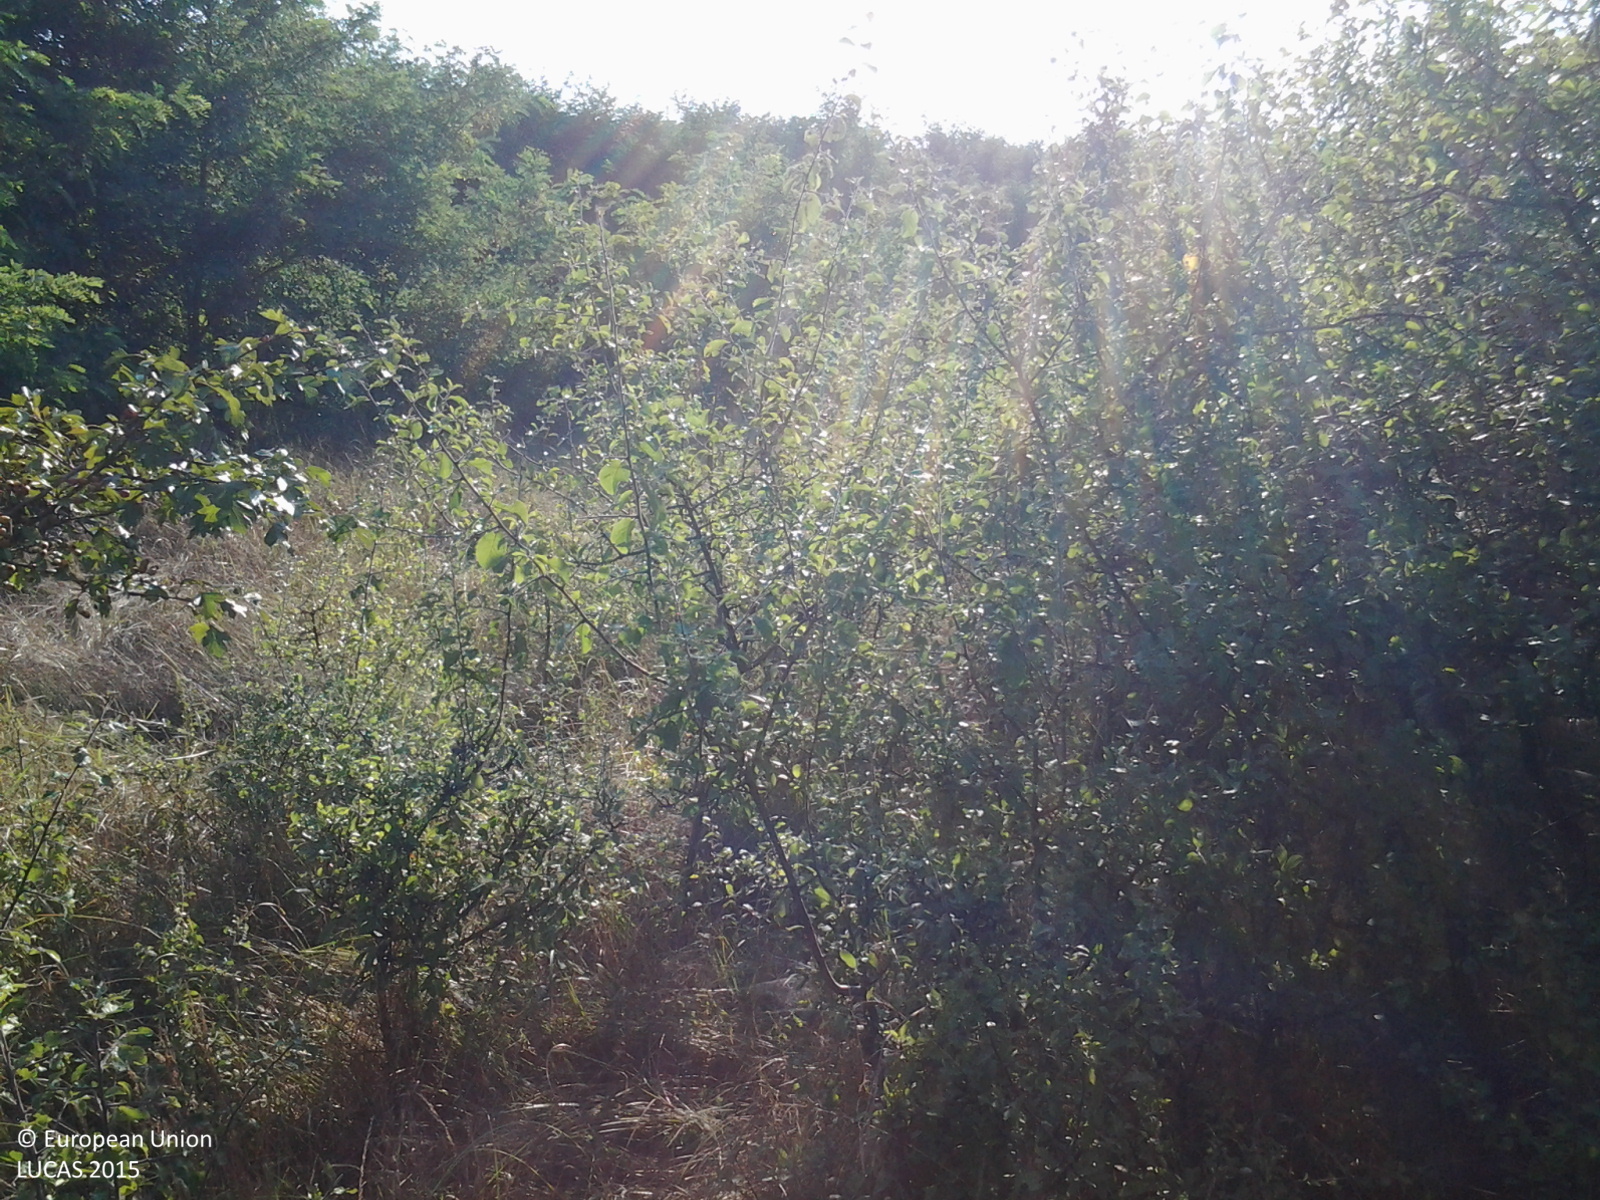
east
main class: Woodland
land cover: Broadleaved woodland
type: mesophytic deciduous forest
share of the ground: > 75 %
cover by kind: broadleaved forest trees 65 %, shrubs 20 %, herbaceous plants 15 %
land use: Forestry
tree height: < 5 m
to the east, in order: Broadleaved woodland; Grassland without tree/shrub cover; Grassland with sparse tree/shrub cover
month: August
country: HU
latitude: 46.8899
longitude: 21.5238
